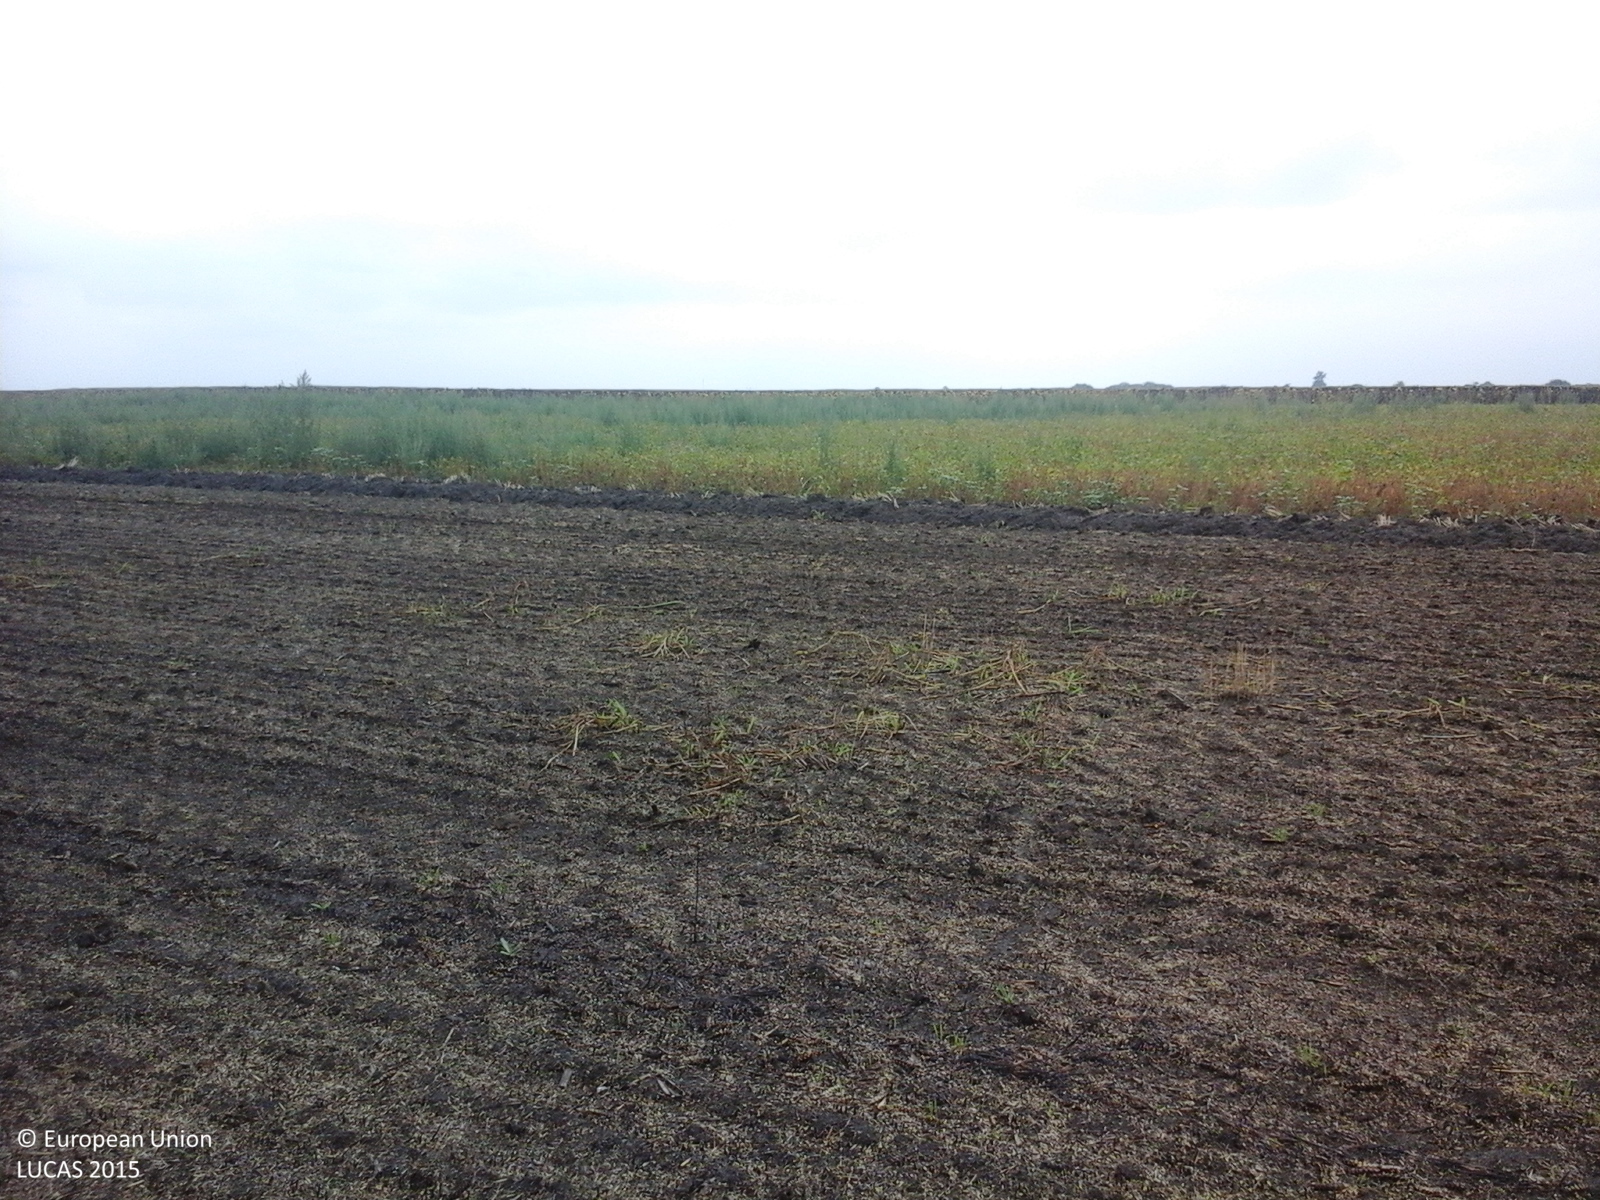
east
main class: Cropland
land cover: Common wheat
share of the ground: < 10 %
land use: Agriculture (excluding fallow land and kitchen gardens)
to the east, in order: Common wheat; Soya; Sunflower
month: August
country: RO
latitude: 46.1417
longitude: 20.3147
